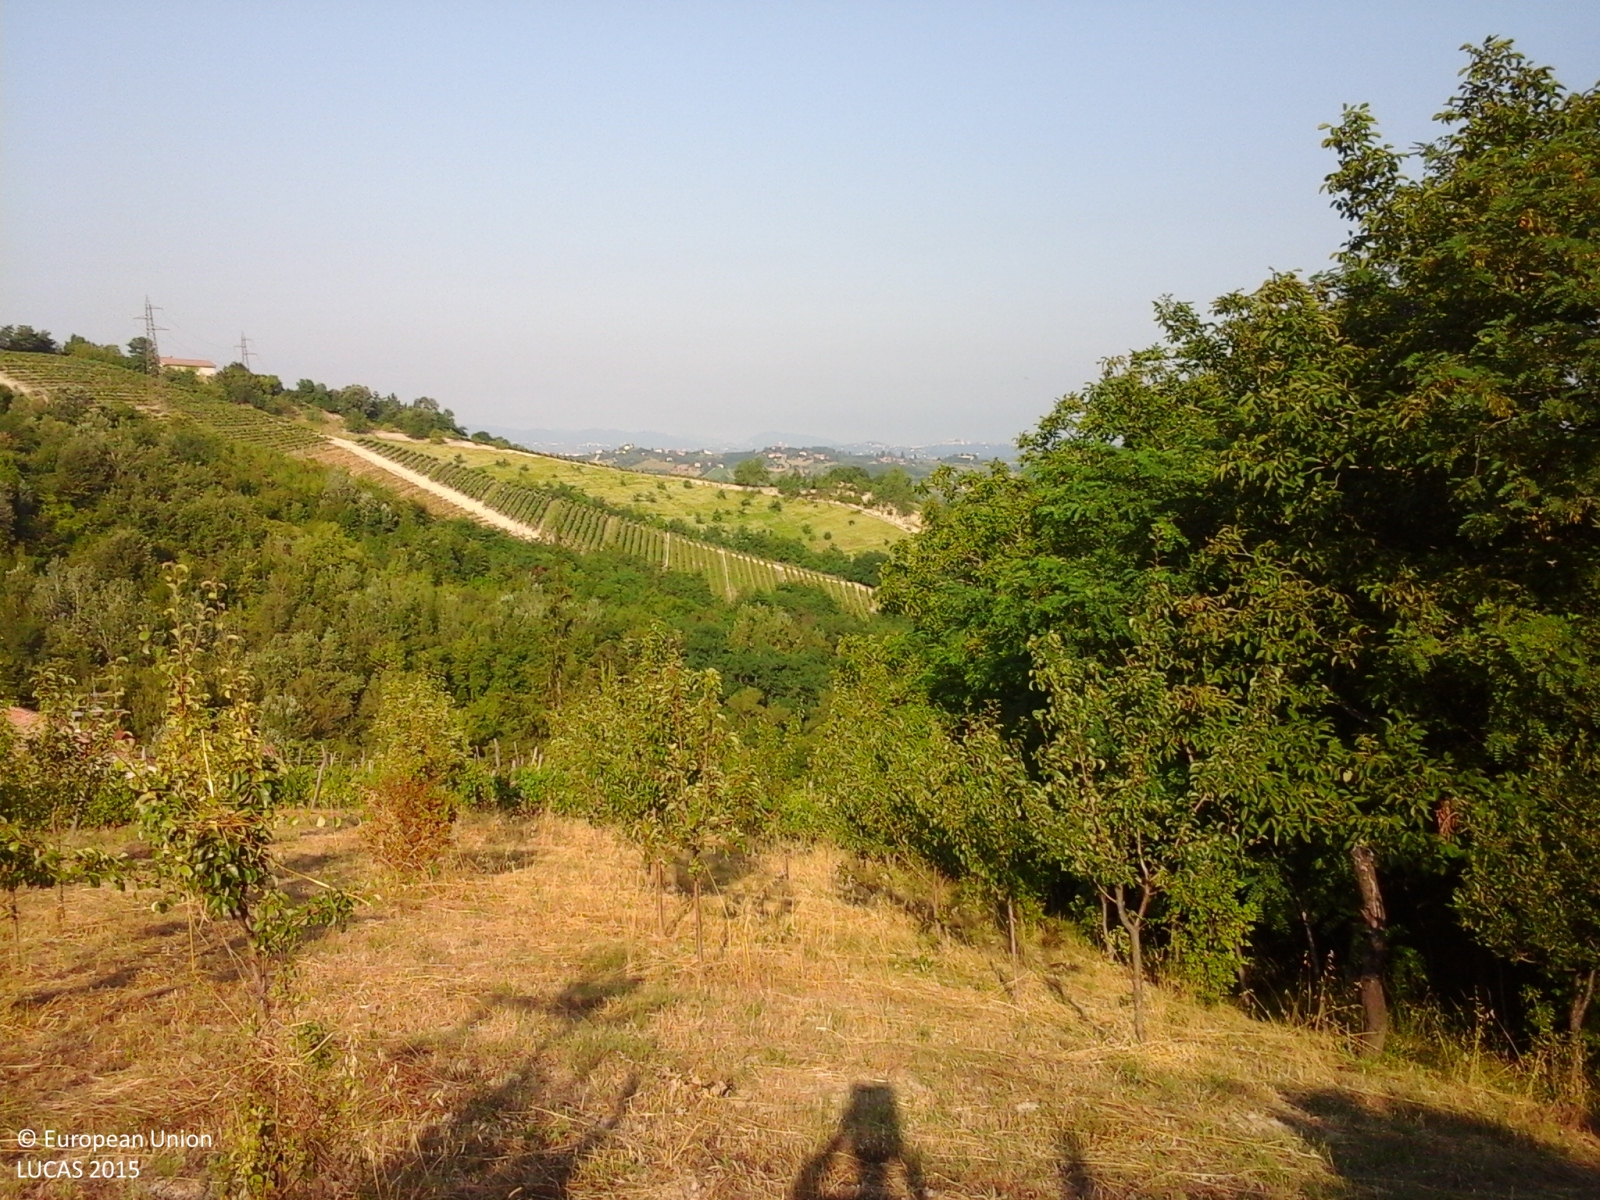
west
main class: Cropland
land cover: Vineyards
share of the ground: 50 - 75 %
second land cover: Grassland without tree/shrub cover
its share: 50 - 75 %
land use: Agriculture (excluding fallow land and kitchen gardens)
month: June
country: IT
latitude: 44.6494
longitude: 8.7291
